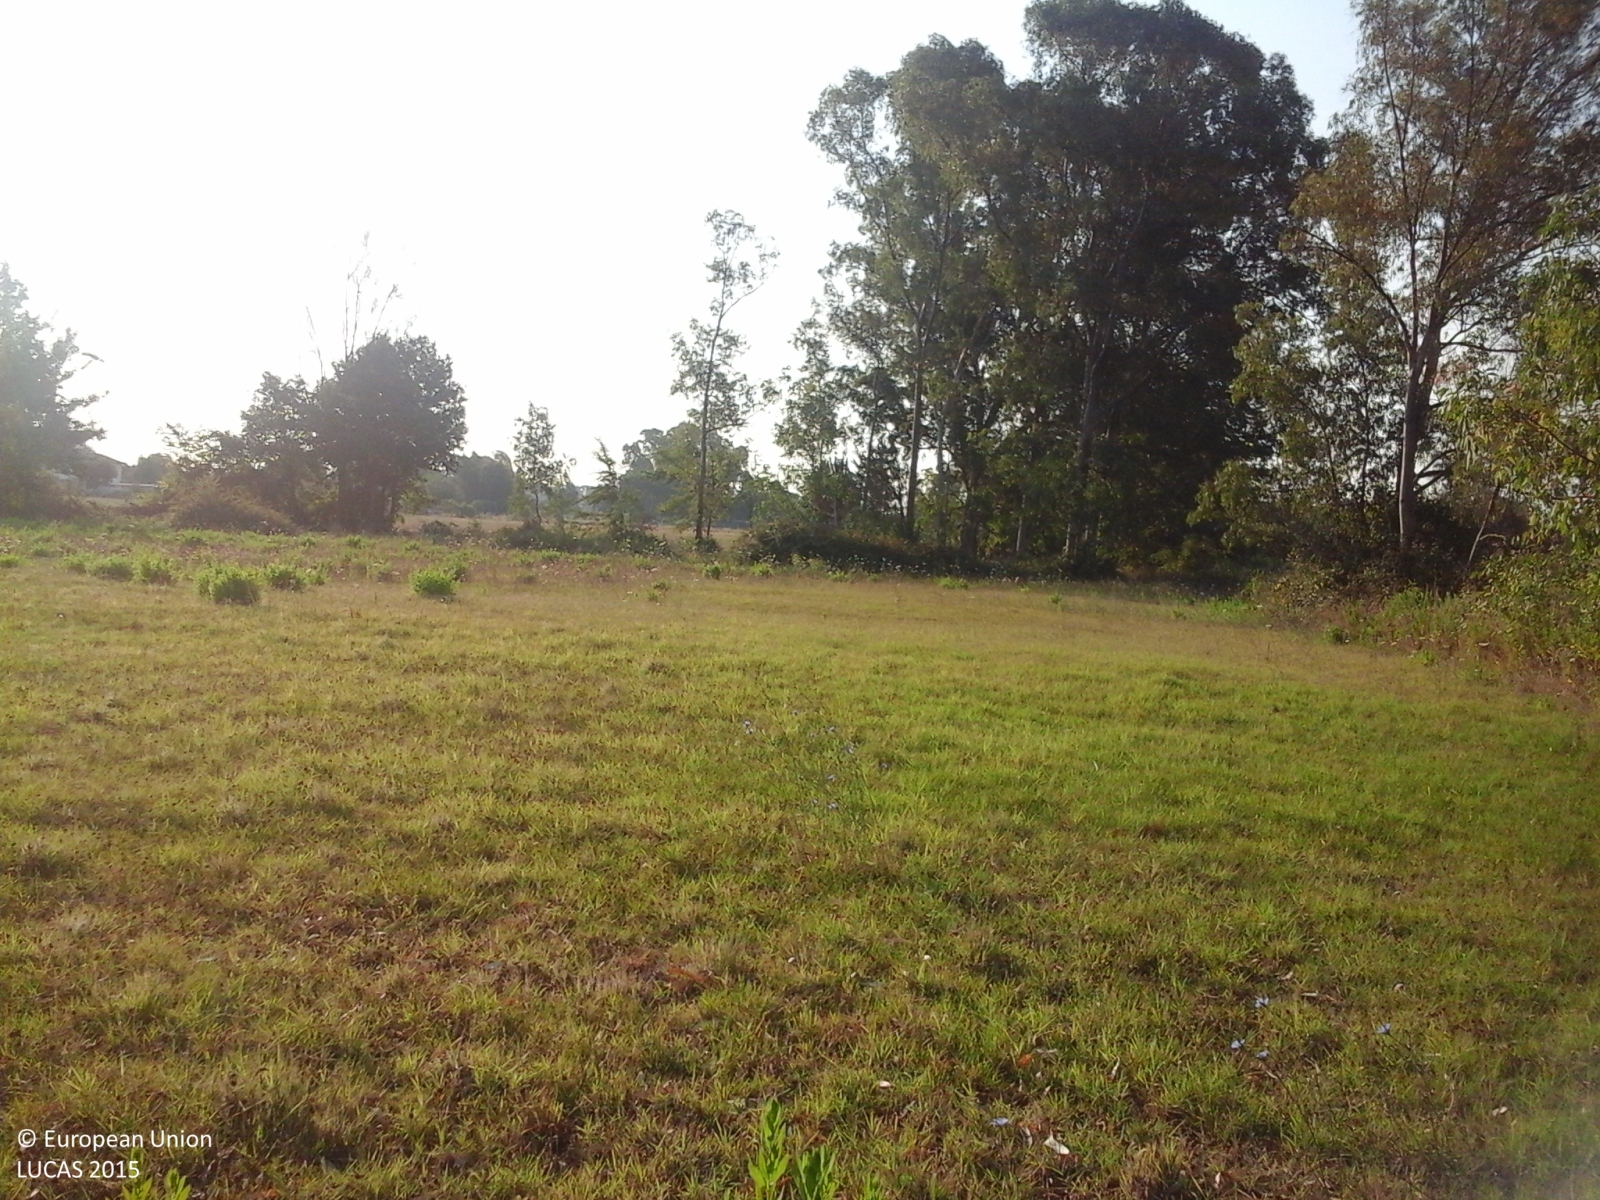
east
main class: Grassland
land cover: Grassland without tree/shrub cover
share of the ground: > 75 %
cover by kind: herbaceous plants 100 %
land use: Residential
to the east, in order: Grassland without tree/shrub cover; Abandoned hedges; Tracks; Grassland without tree/shrub cover; Single bushes/trees; Fences; Abandoned hedges; Grassland without tree/shrub cover; Tracks; Ditches and canals; Abandoned hedges; Grassland without tree/shrub cover
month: July
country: IT
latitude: 41.4575
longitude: 12.8259
